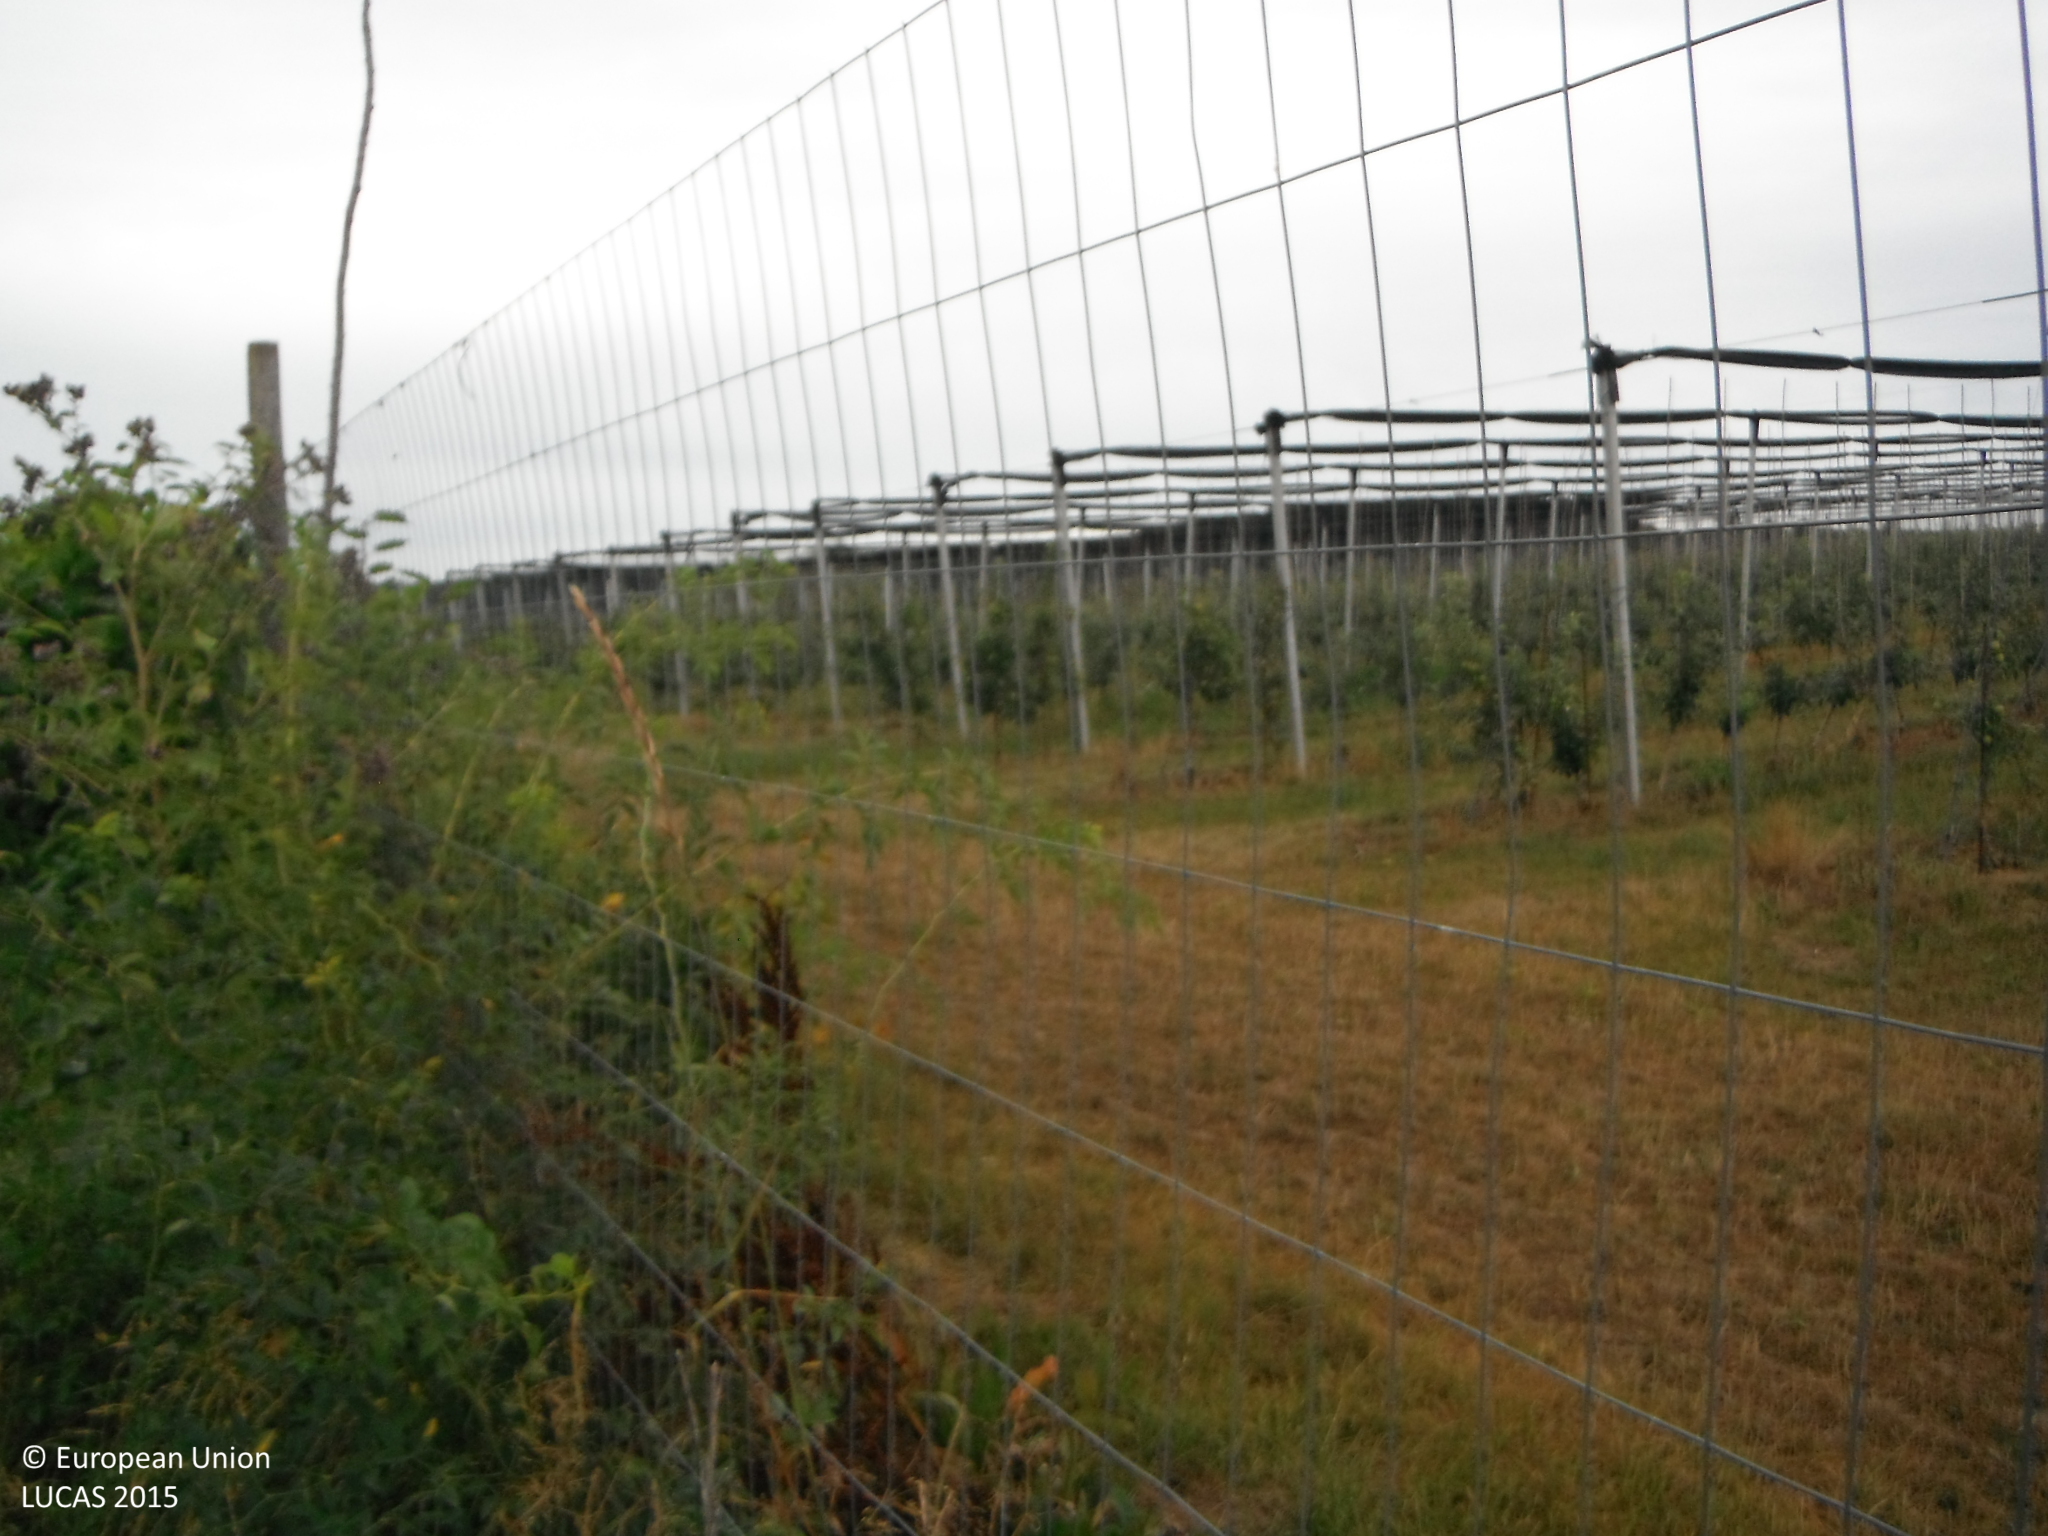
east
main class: Cropland
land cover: Permanent crops (only in case pi)
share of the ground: 50 - 75 %
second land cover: Grassland without tree/shrub cover
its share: > 75 %
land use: Agriculture (excluding fallow land and kitchen gardens)
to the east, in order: Permanent crops (only in case pi); Grassland without tree/shrub cover; Grass margins; Tracks; Grass margins; Shrubland with sparse tree cover; Tracks; Grassland with sparse tree/shrub cover; Permanent crops (only in case pi)
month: July
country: SK
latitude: 48.6510
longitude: 18.3096
